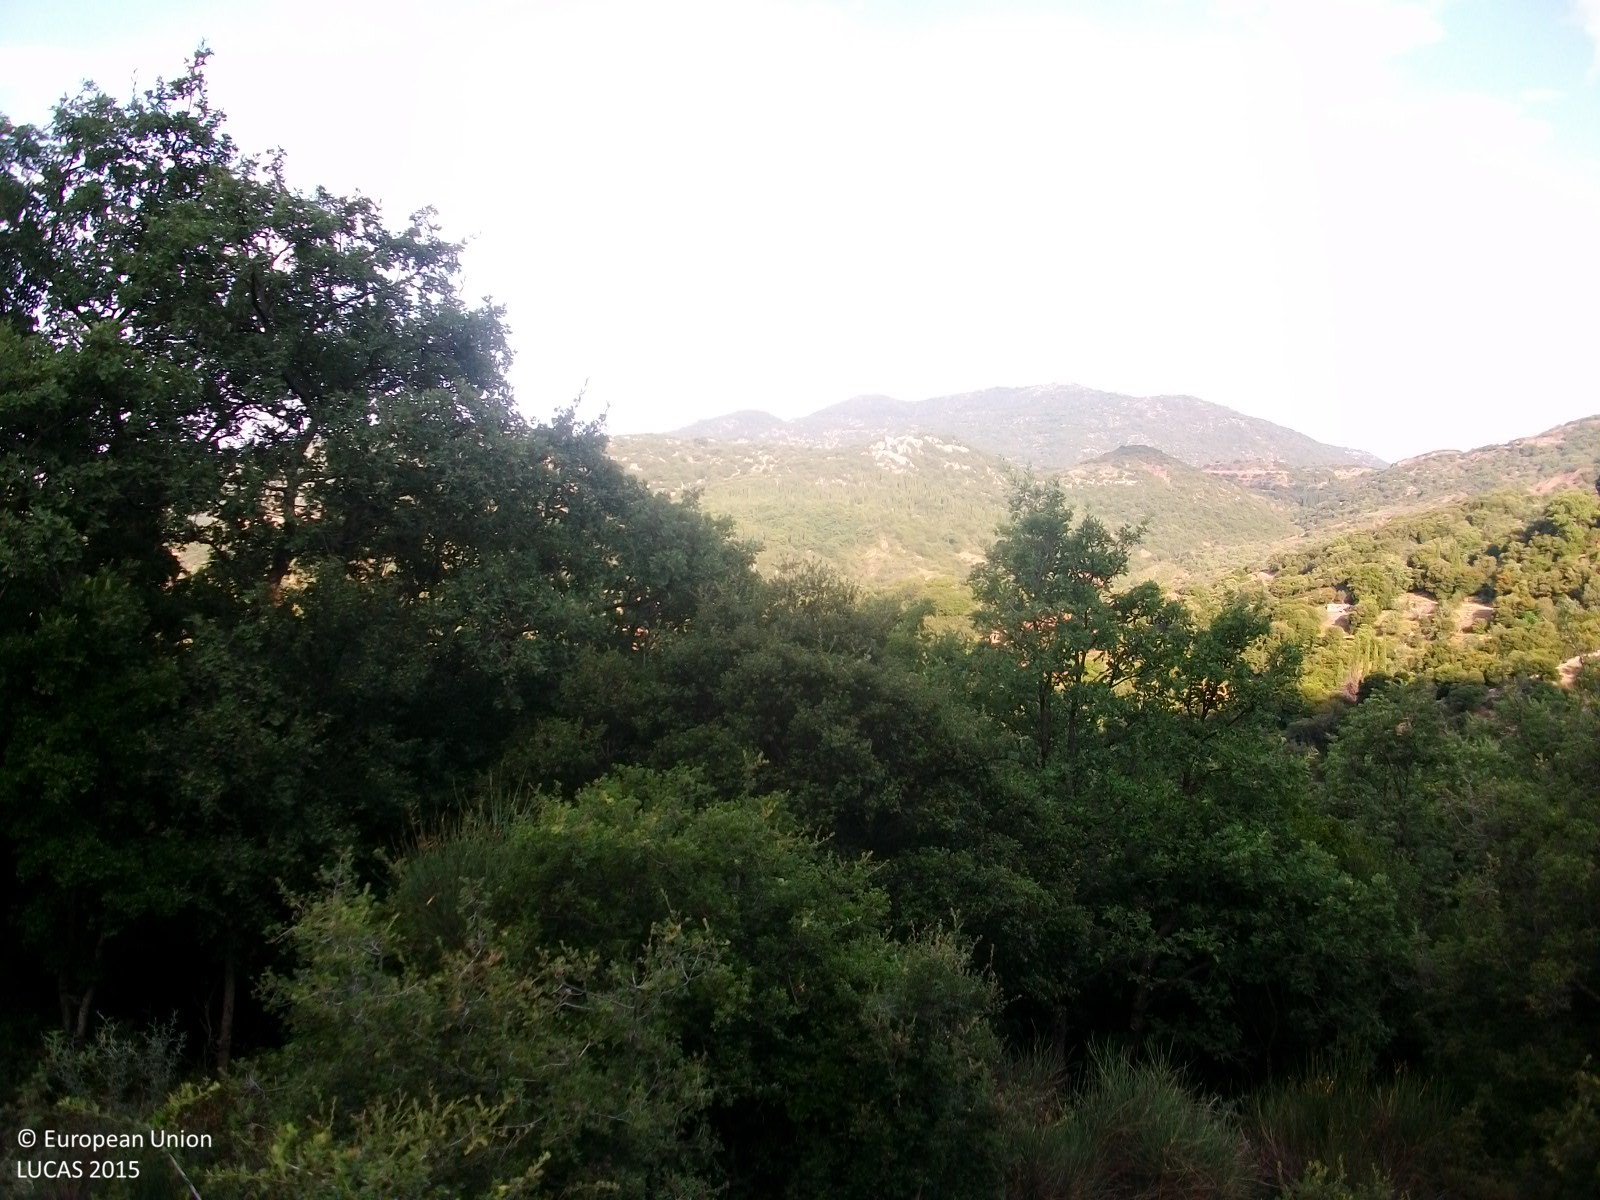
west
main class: Shrubland
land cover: Shrubland with sparse tree cover
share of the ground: > 75 %
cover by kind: shrubs 95 %, broadleaved forest trees 5 %
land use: Semi-natural and natural areas not in use
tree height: > 5 m
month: August
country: GR
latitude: 37.3591
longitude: 21.9361
